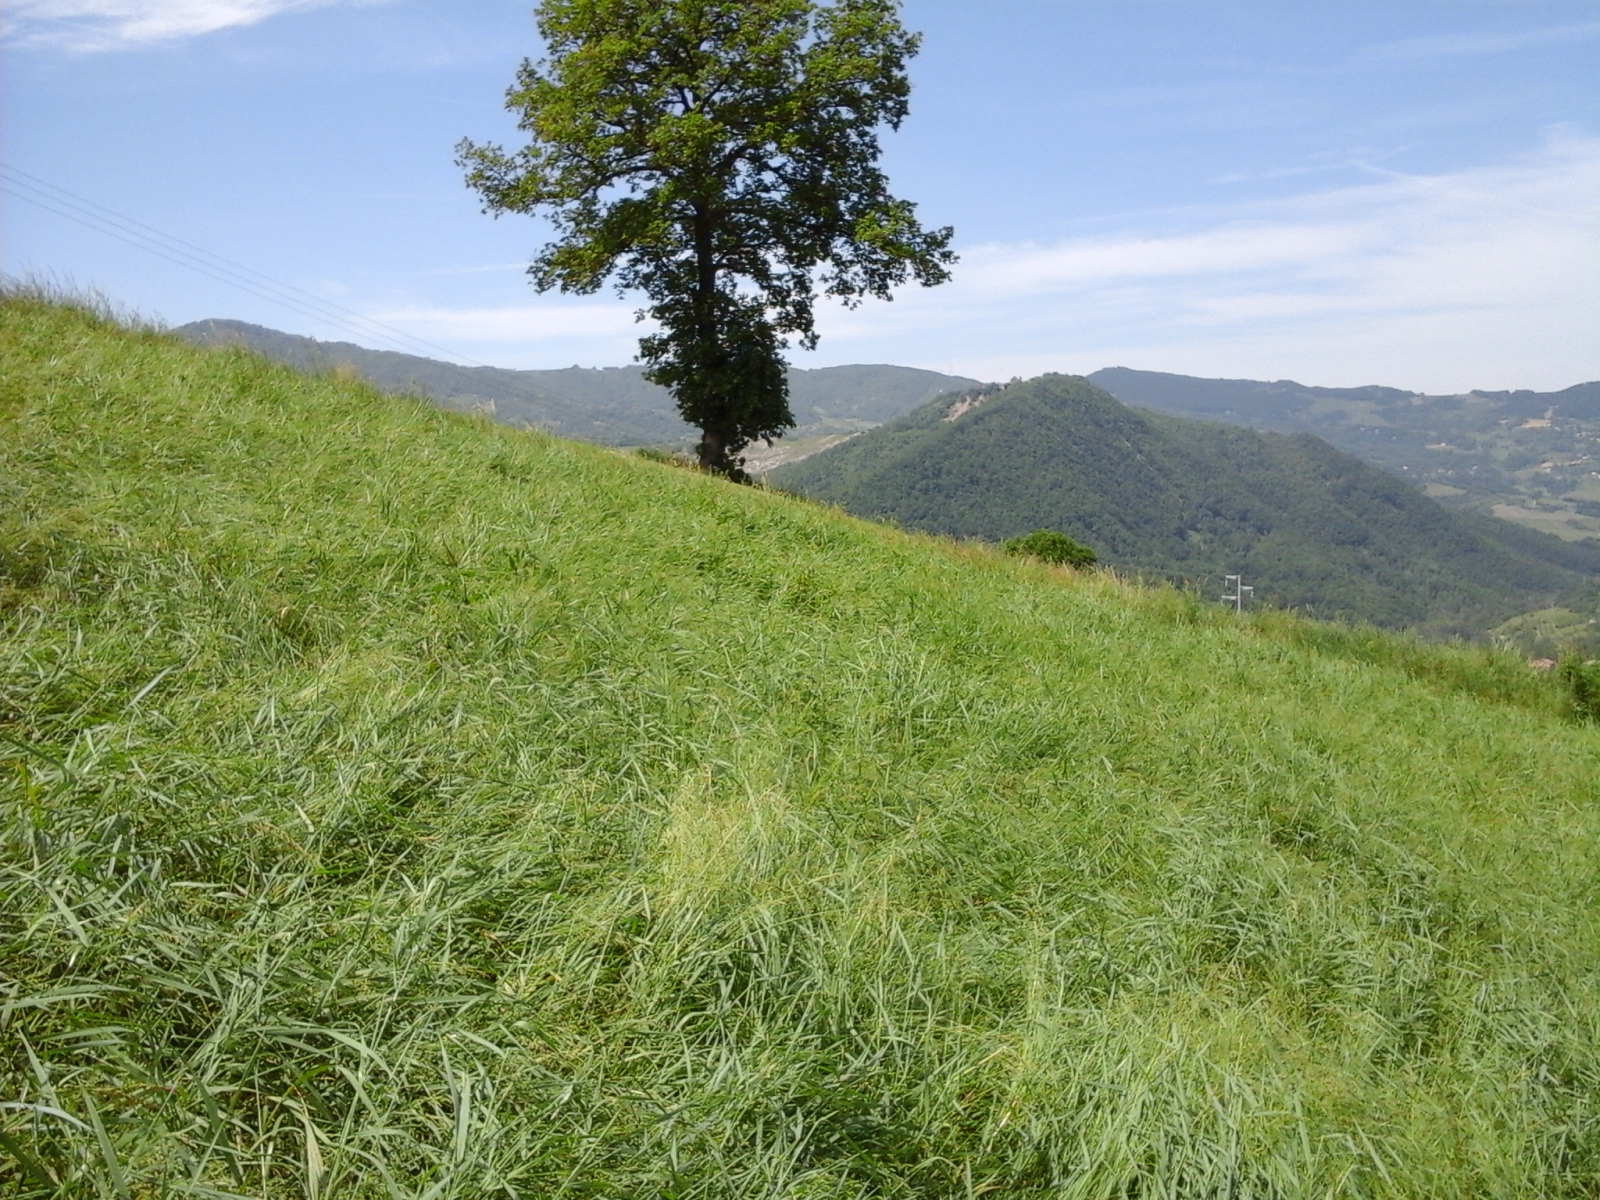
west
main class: Cropland
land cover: Lucerne
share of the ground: > 75 %
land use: Agriculture (excluding fallow land and kitchen gardens)
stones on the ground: < 10 %
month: May
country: IT
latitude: 44.4020
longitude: 10.7391
